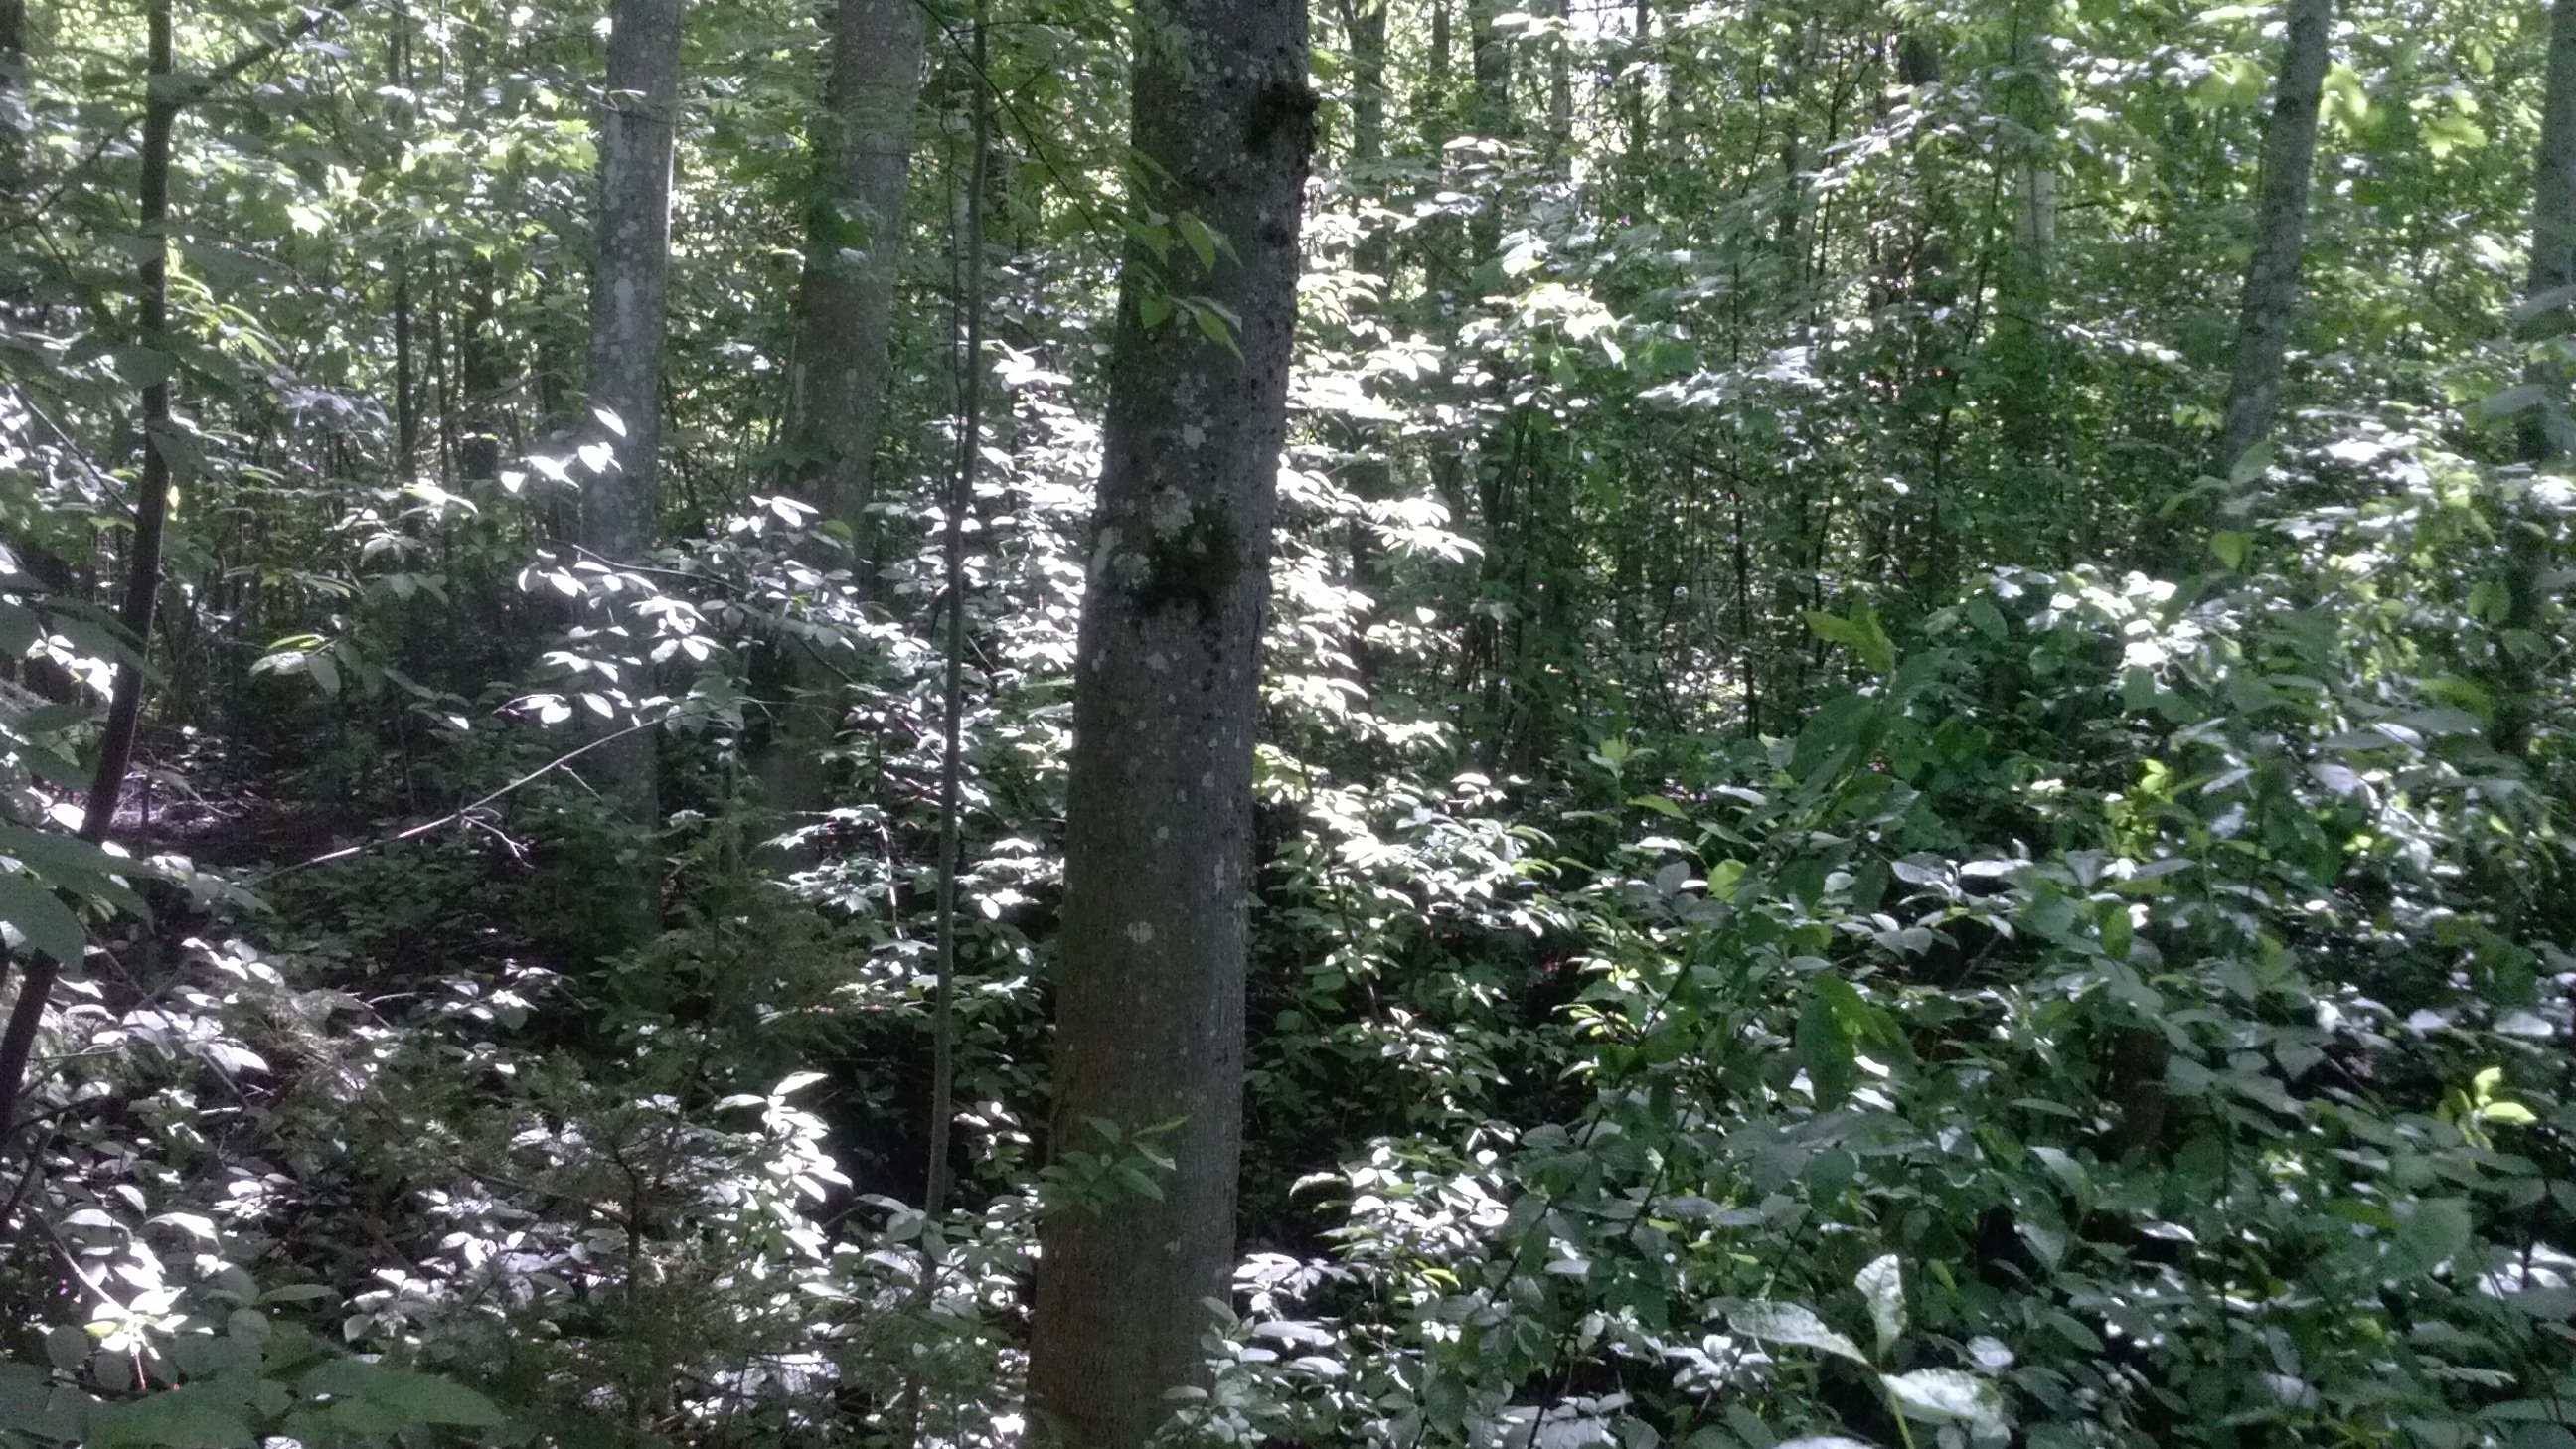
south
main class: Woodland
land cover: Broadleaved woodland
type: non-riverine alder, birch or aspen forest
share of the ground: > 75 %
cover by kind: broadleaved forest trees 80 %, shrubs 10 %, herbaceous plants 10 %
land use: Forestry
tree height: > 5 m
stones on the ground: < 10 %
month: May
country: LV
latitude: 56.2920
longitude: 27.1497
